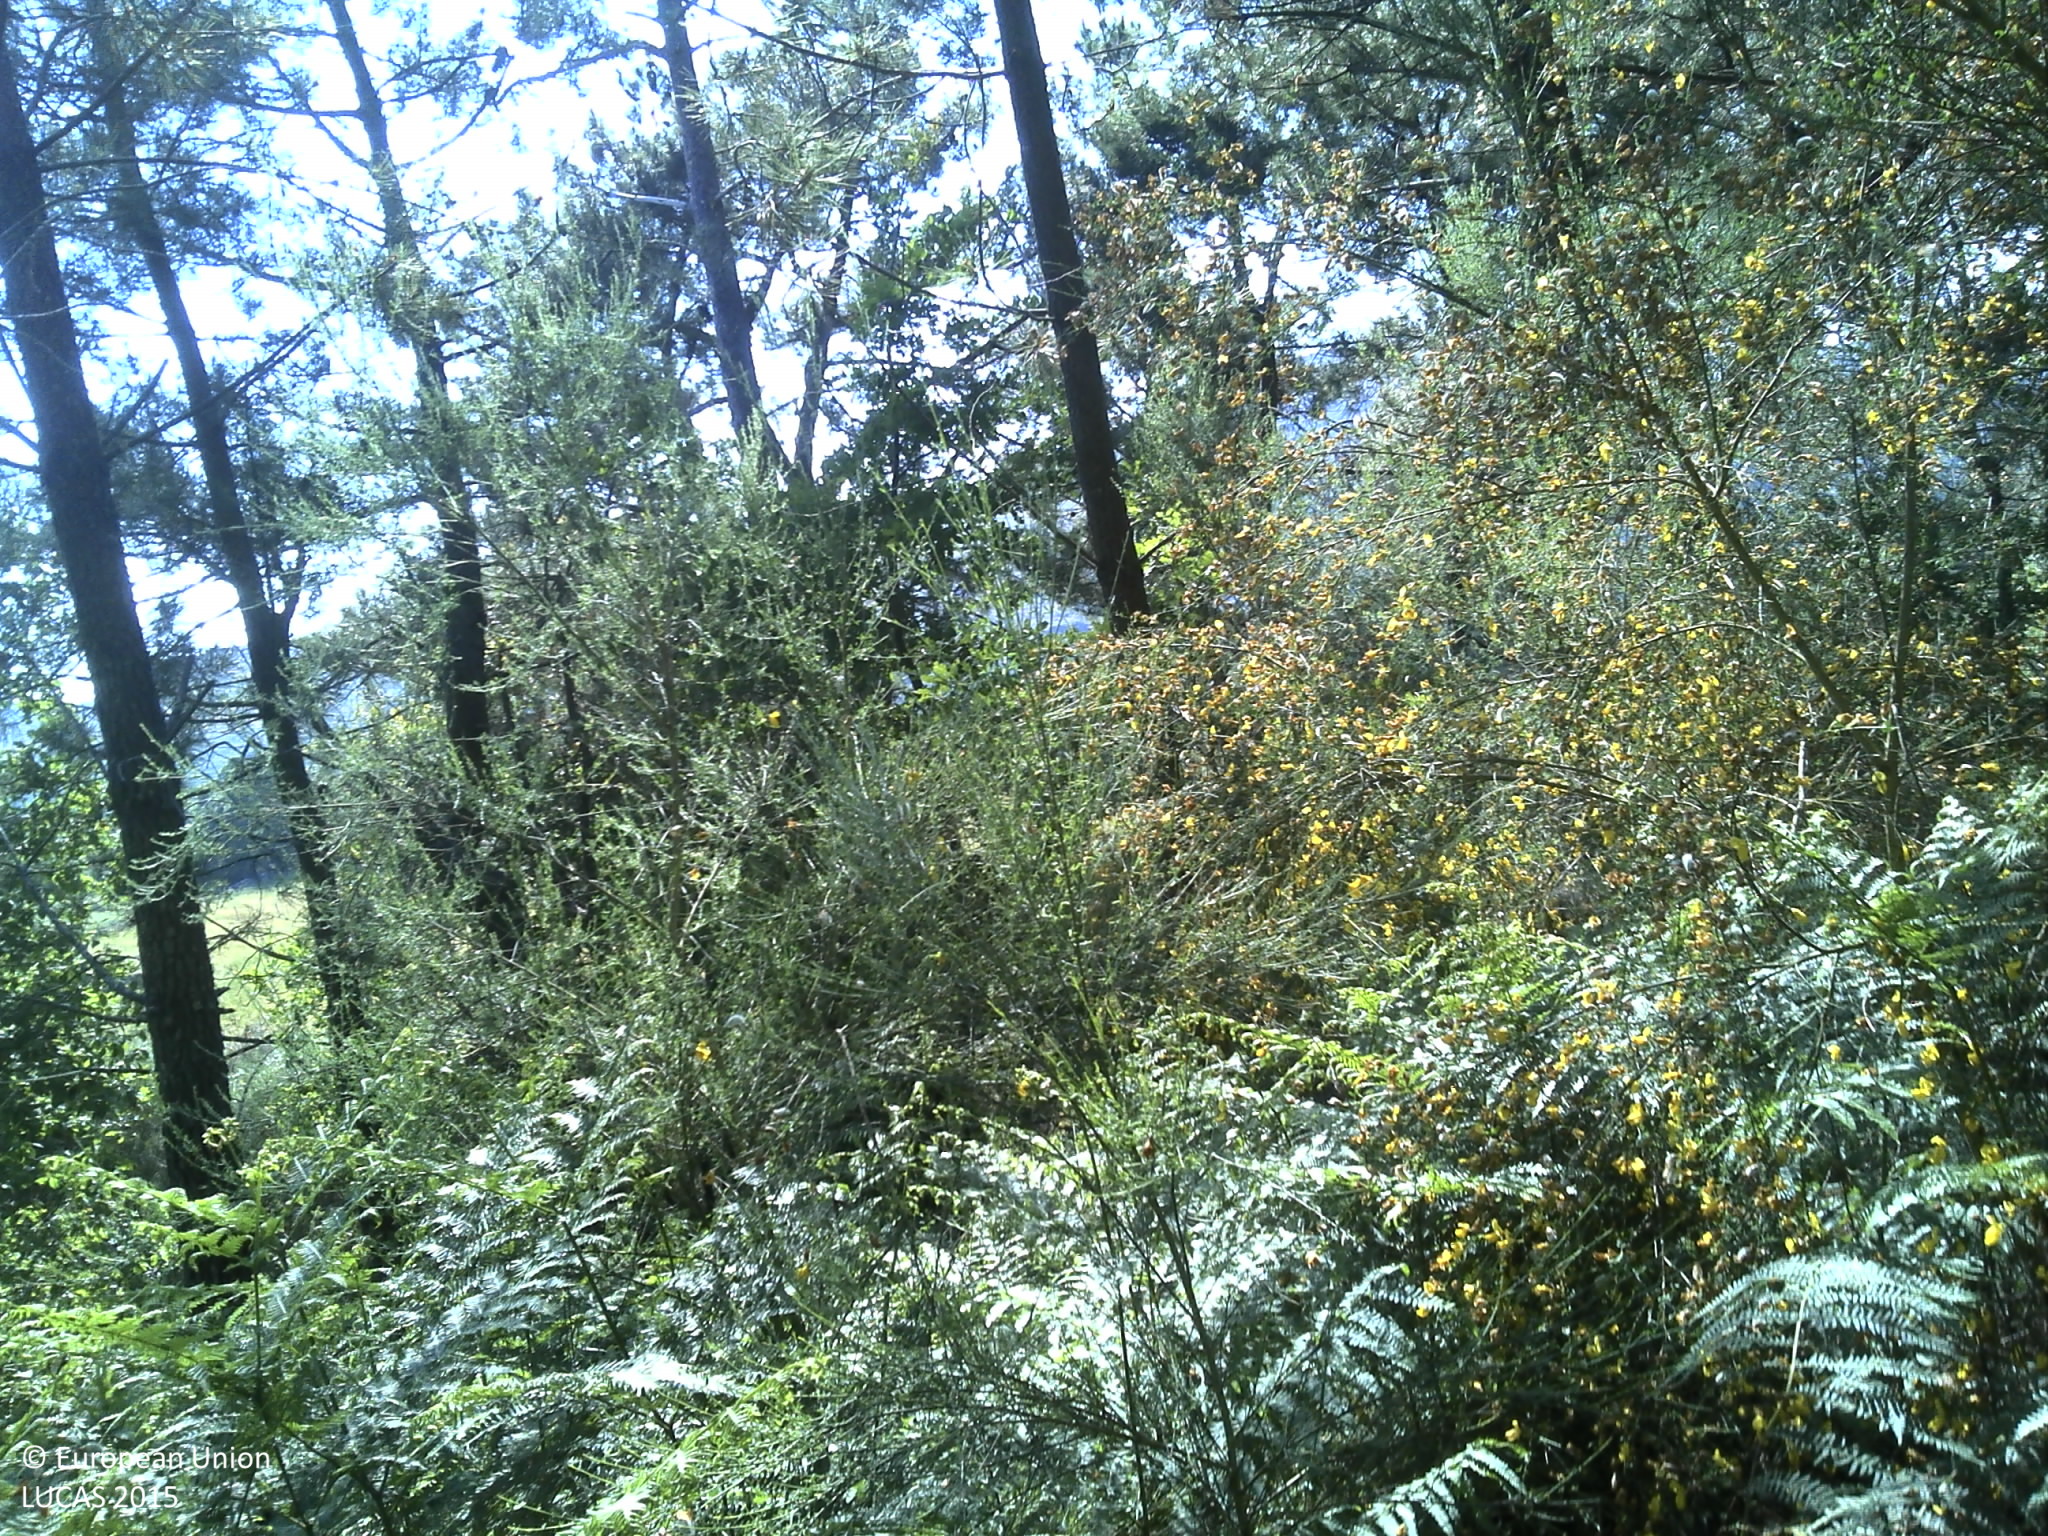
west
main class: Woodland
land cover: Pine dominated coniferous woodland
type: coniferous forest of the mediterranean region
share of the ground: > 75 %
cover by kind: coniferous forest trees 80 %, shrubs 20 %
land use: Forestry
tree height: > 5 m
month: June
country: PT
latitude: 42.0646
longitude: -8.2731
